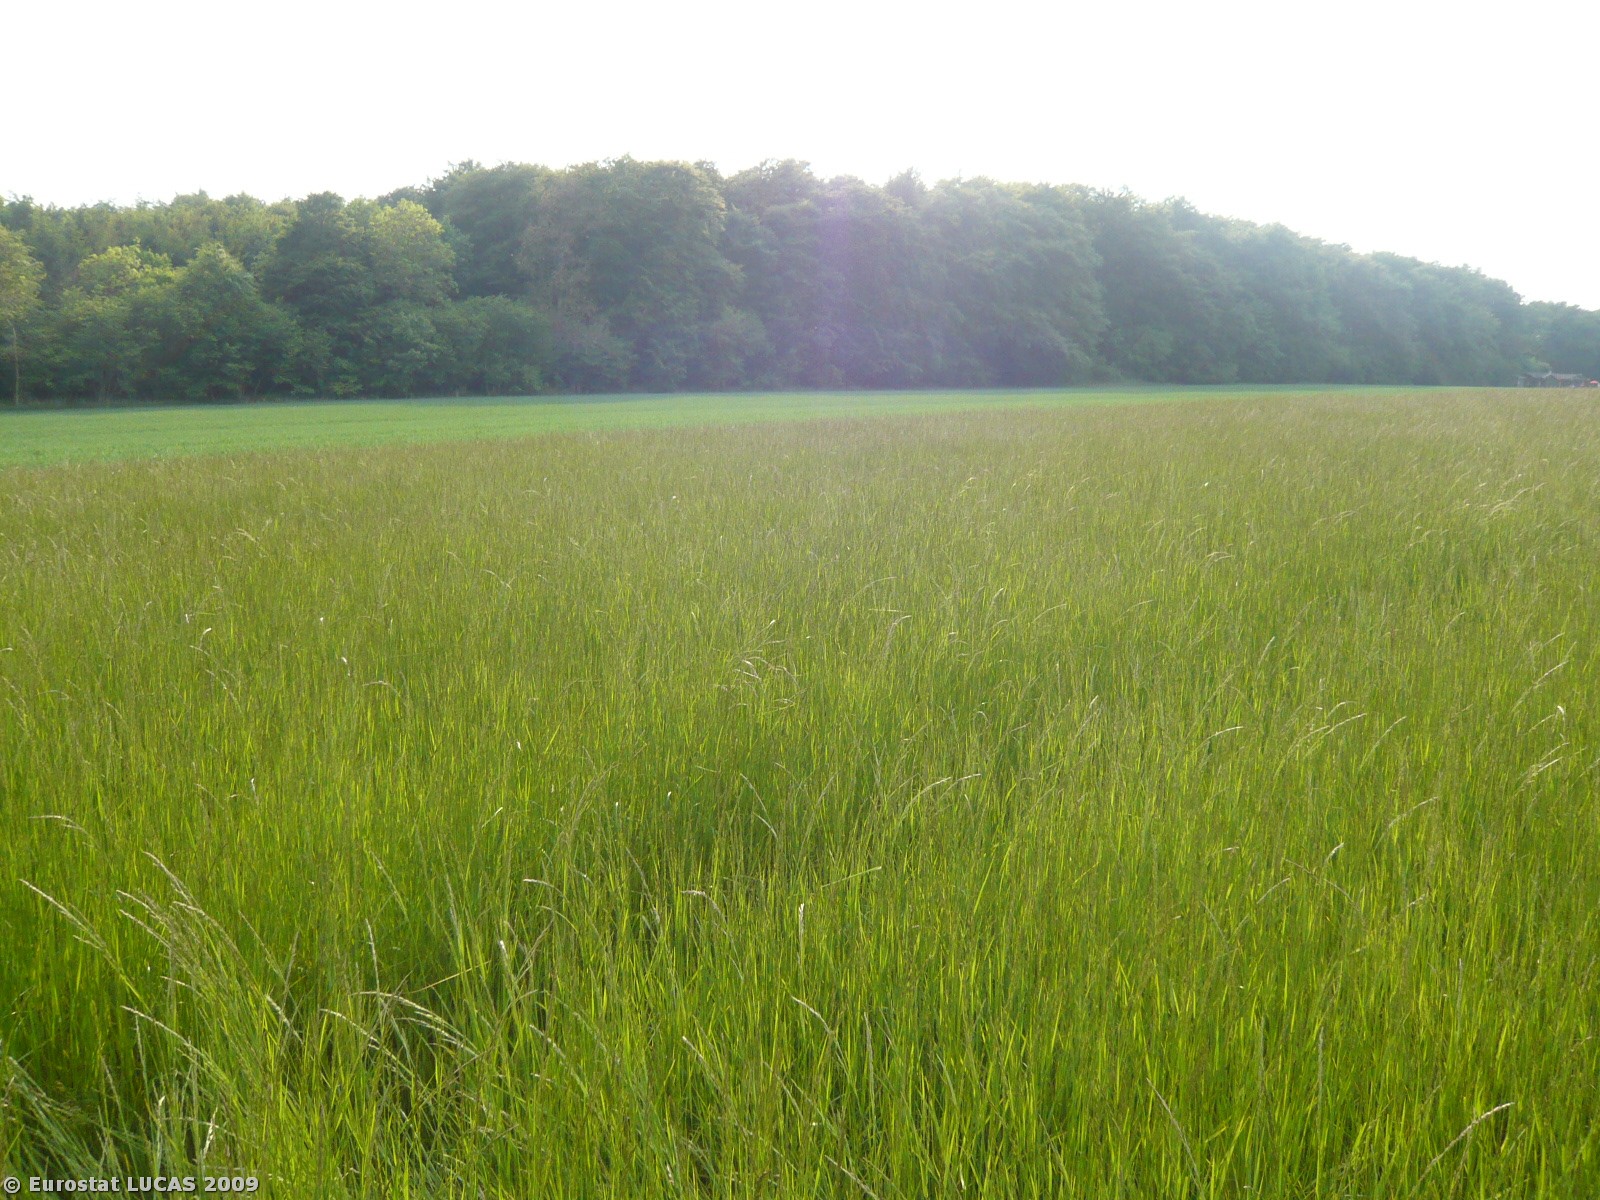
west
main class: Grassland
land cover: Grassland without tree/shrub cover
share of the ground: > 75 %
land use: Agriculture (excluding fallow land and kitchen gardens)
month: May
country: DK
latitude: 55.2059
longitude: 11.6801
